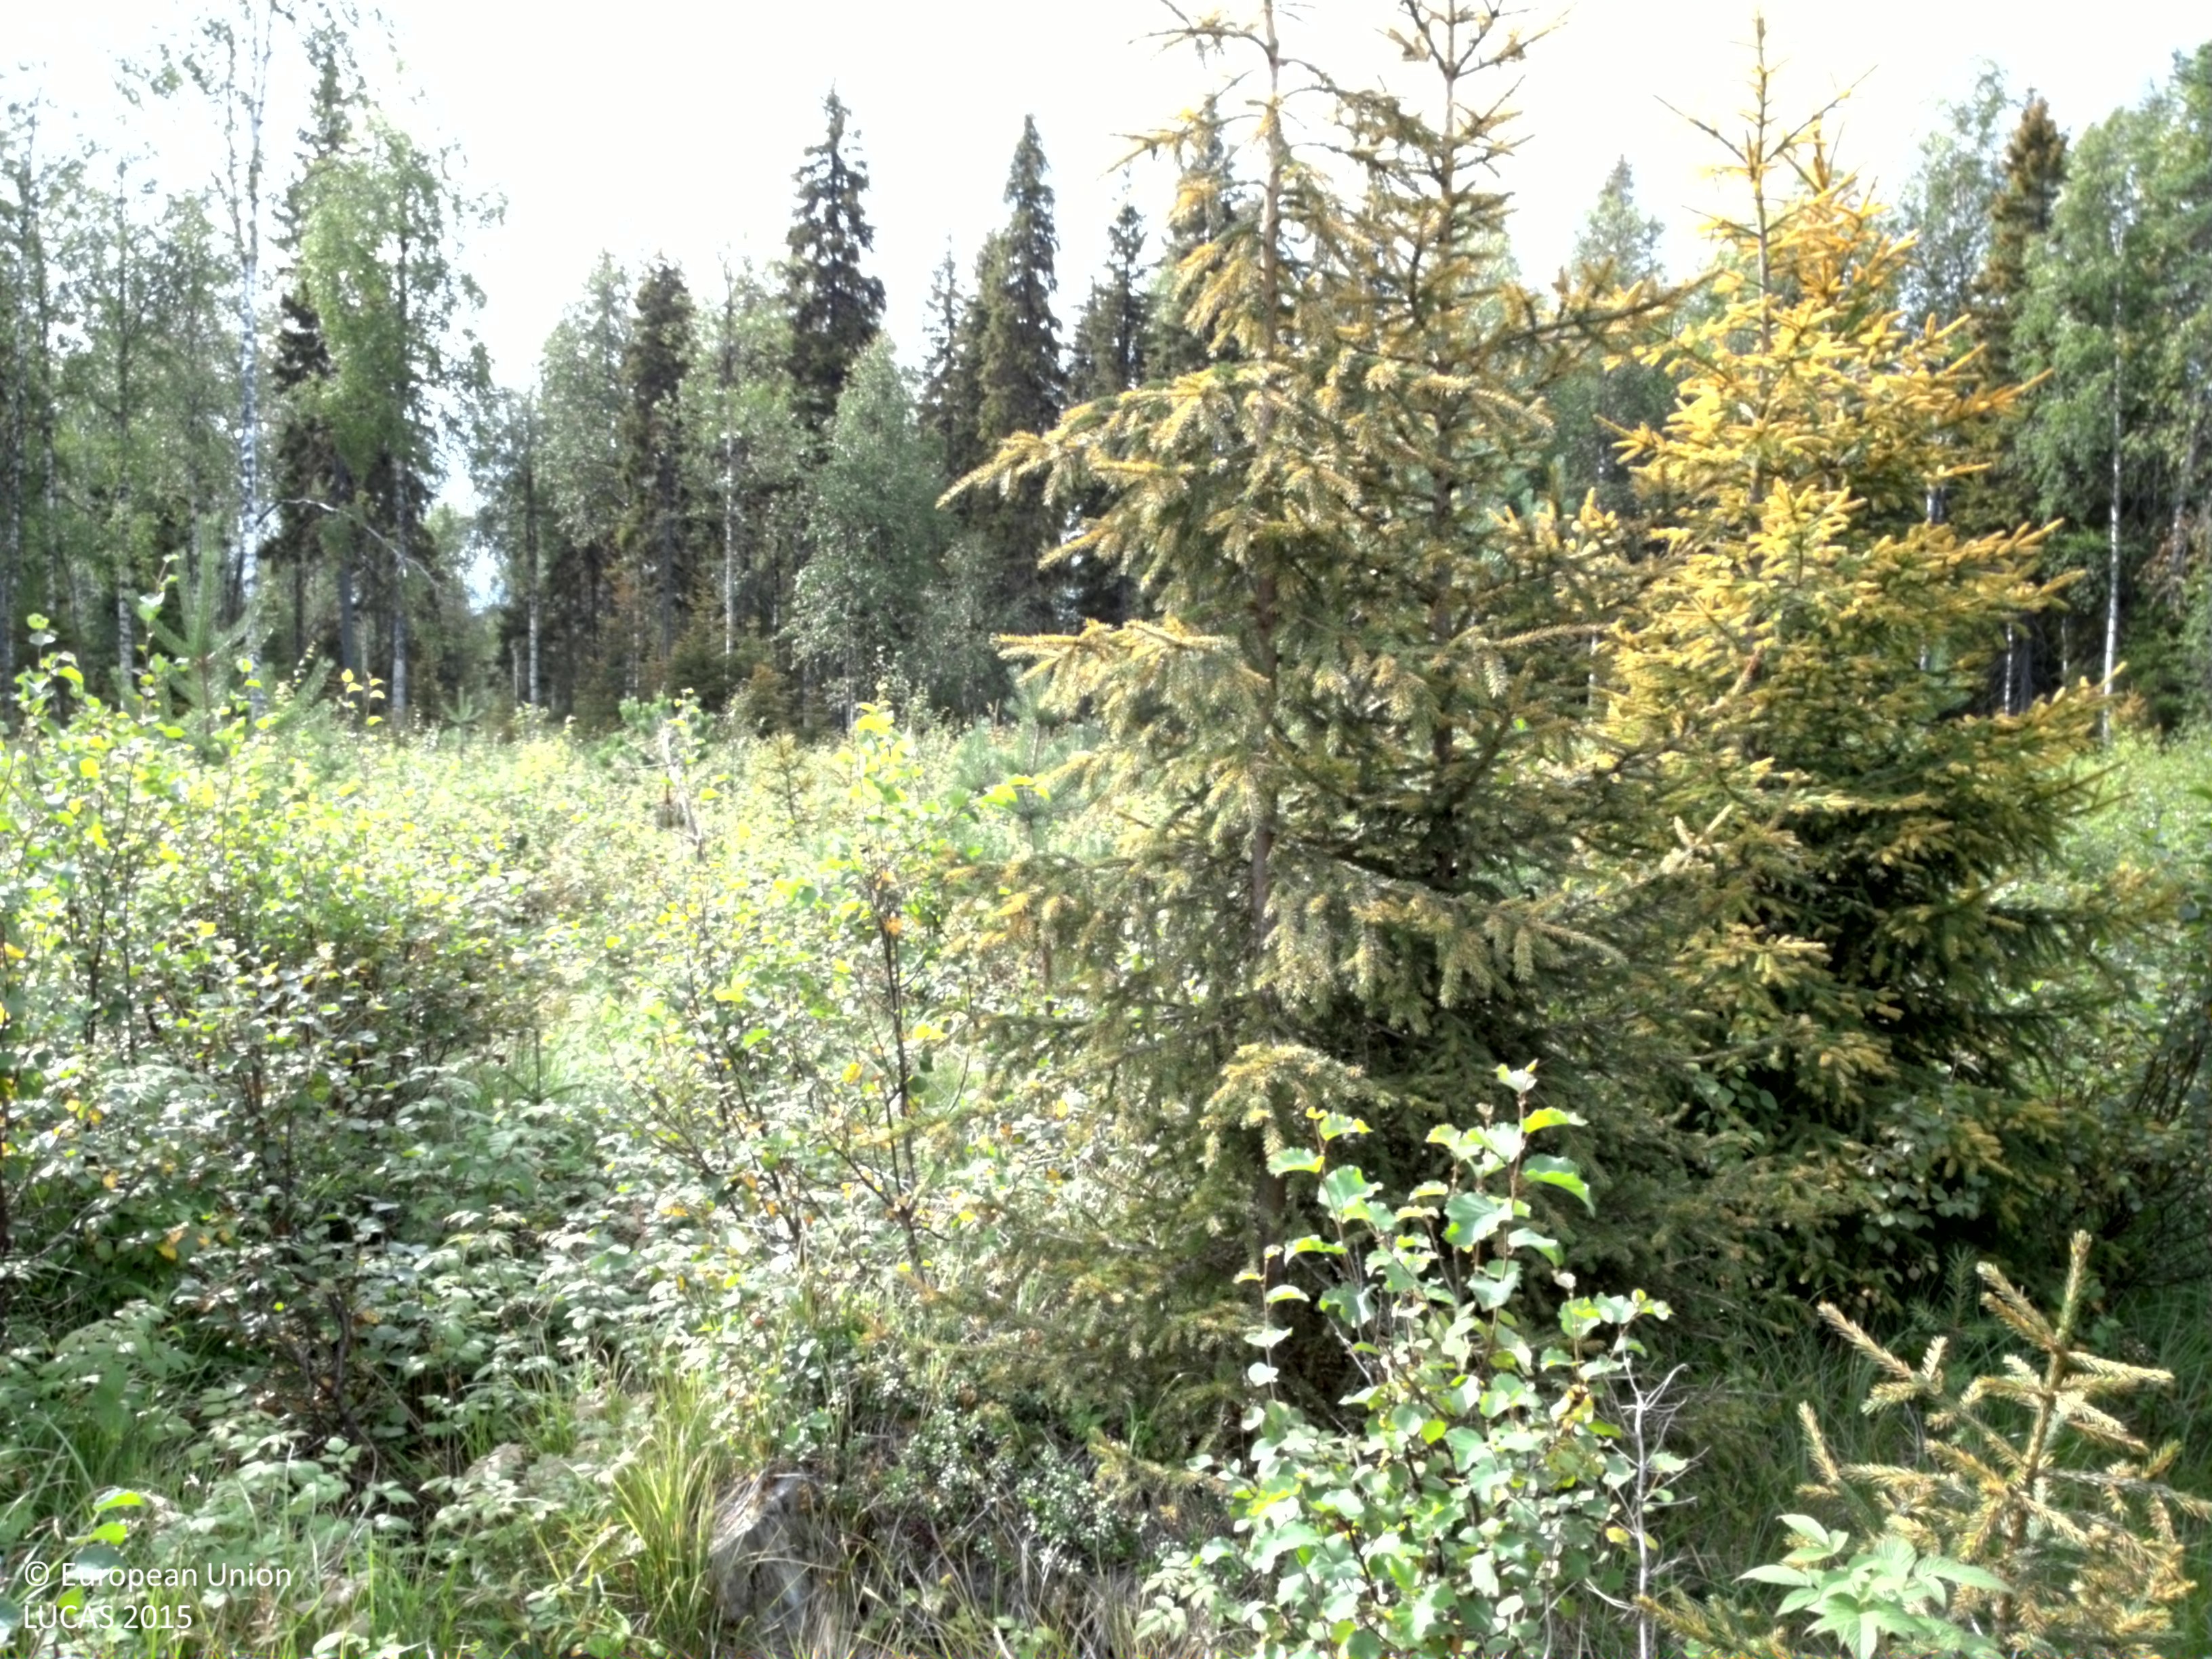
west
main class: Woodland
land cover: Other mixed woodland
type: boreal forest
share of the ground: 50 - 75 %
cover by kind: broadleaved forest trees 35 %, shrubs 35 %, coniferous forest trees 15 %, herbaceous plants 15 %
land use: Forestry
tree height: < 5 m
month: August
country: SE
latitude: 65.9830
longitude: 22.6408
